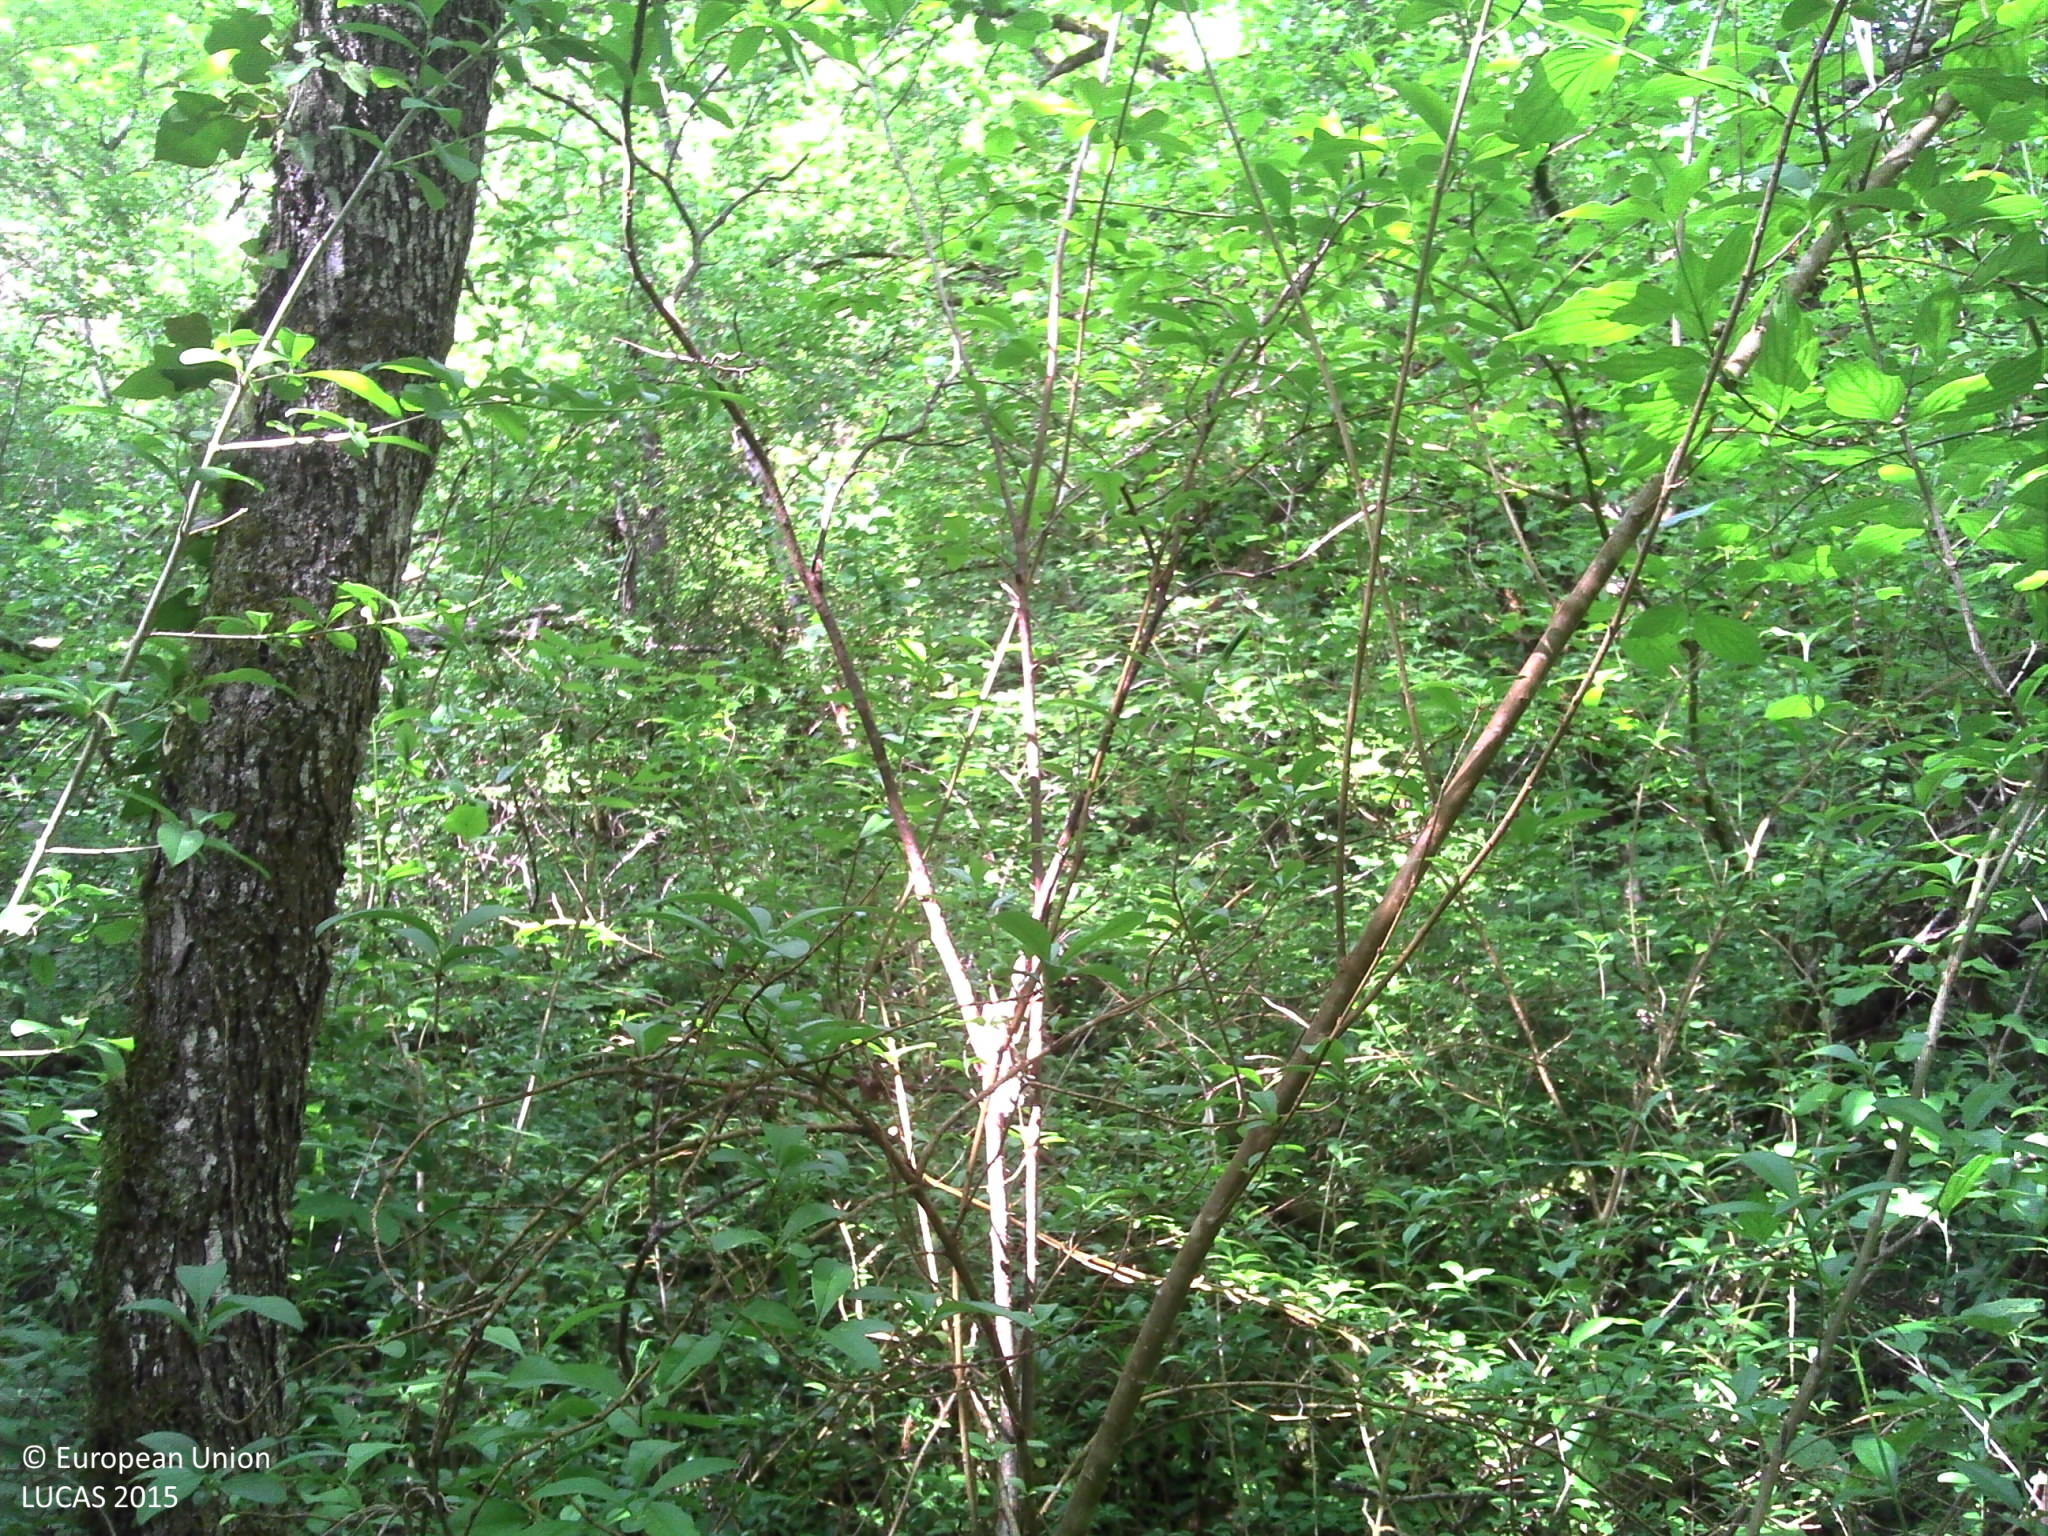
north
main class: Woodland
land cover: Broadleaved woodland
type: mesophytic deciduous forest
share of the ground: > 75 %
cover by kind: broadleaved forest trees 90 %, herbaceous plants 5 %, lichens and mosses 5 %
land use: Forestry
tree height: > 5 m
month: May
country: FR
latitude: 47.8232
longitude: 4.2944
